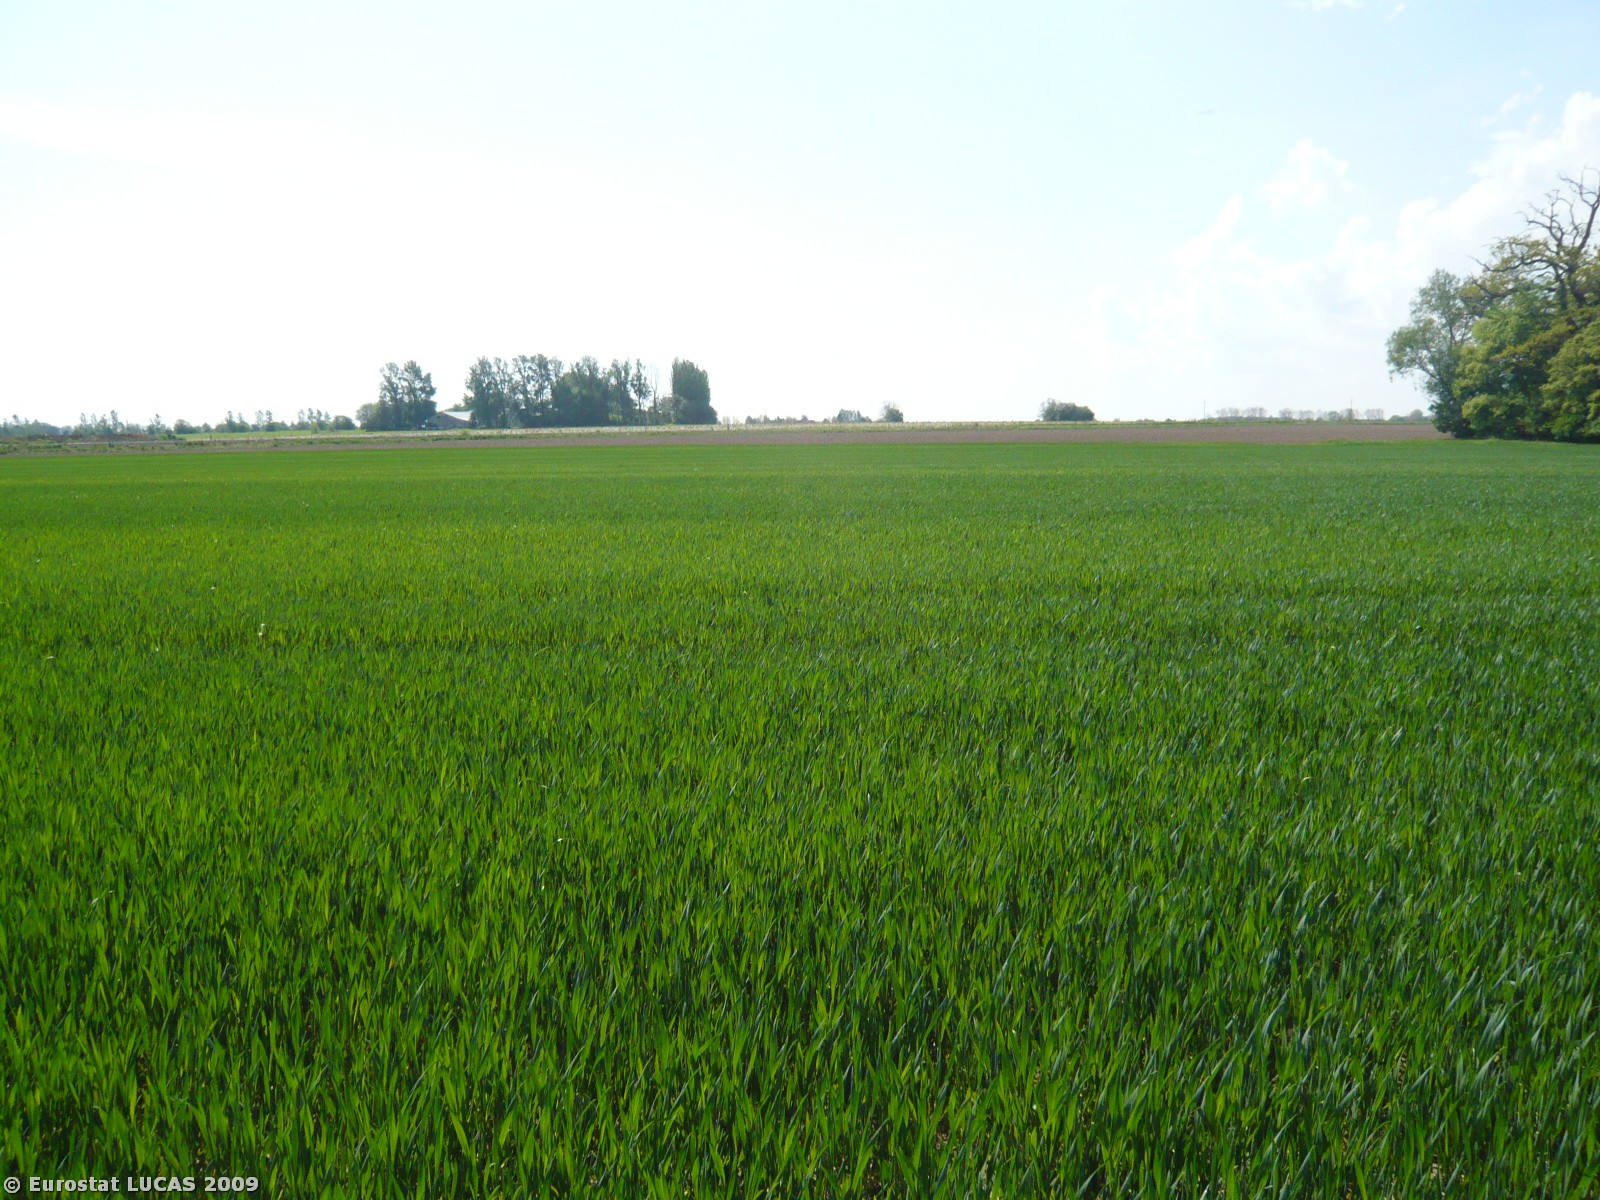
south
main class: Cropland
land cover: Common wheat
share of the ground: > 75 %
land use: Agriculture (excluding fallow land and kitchen gardens)
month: May
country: DK
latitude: 55.3060
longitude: 12.1881
